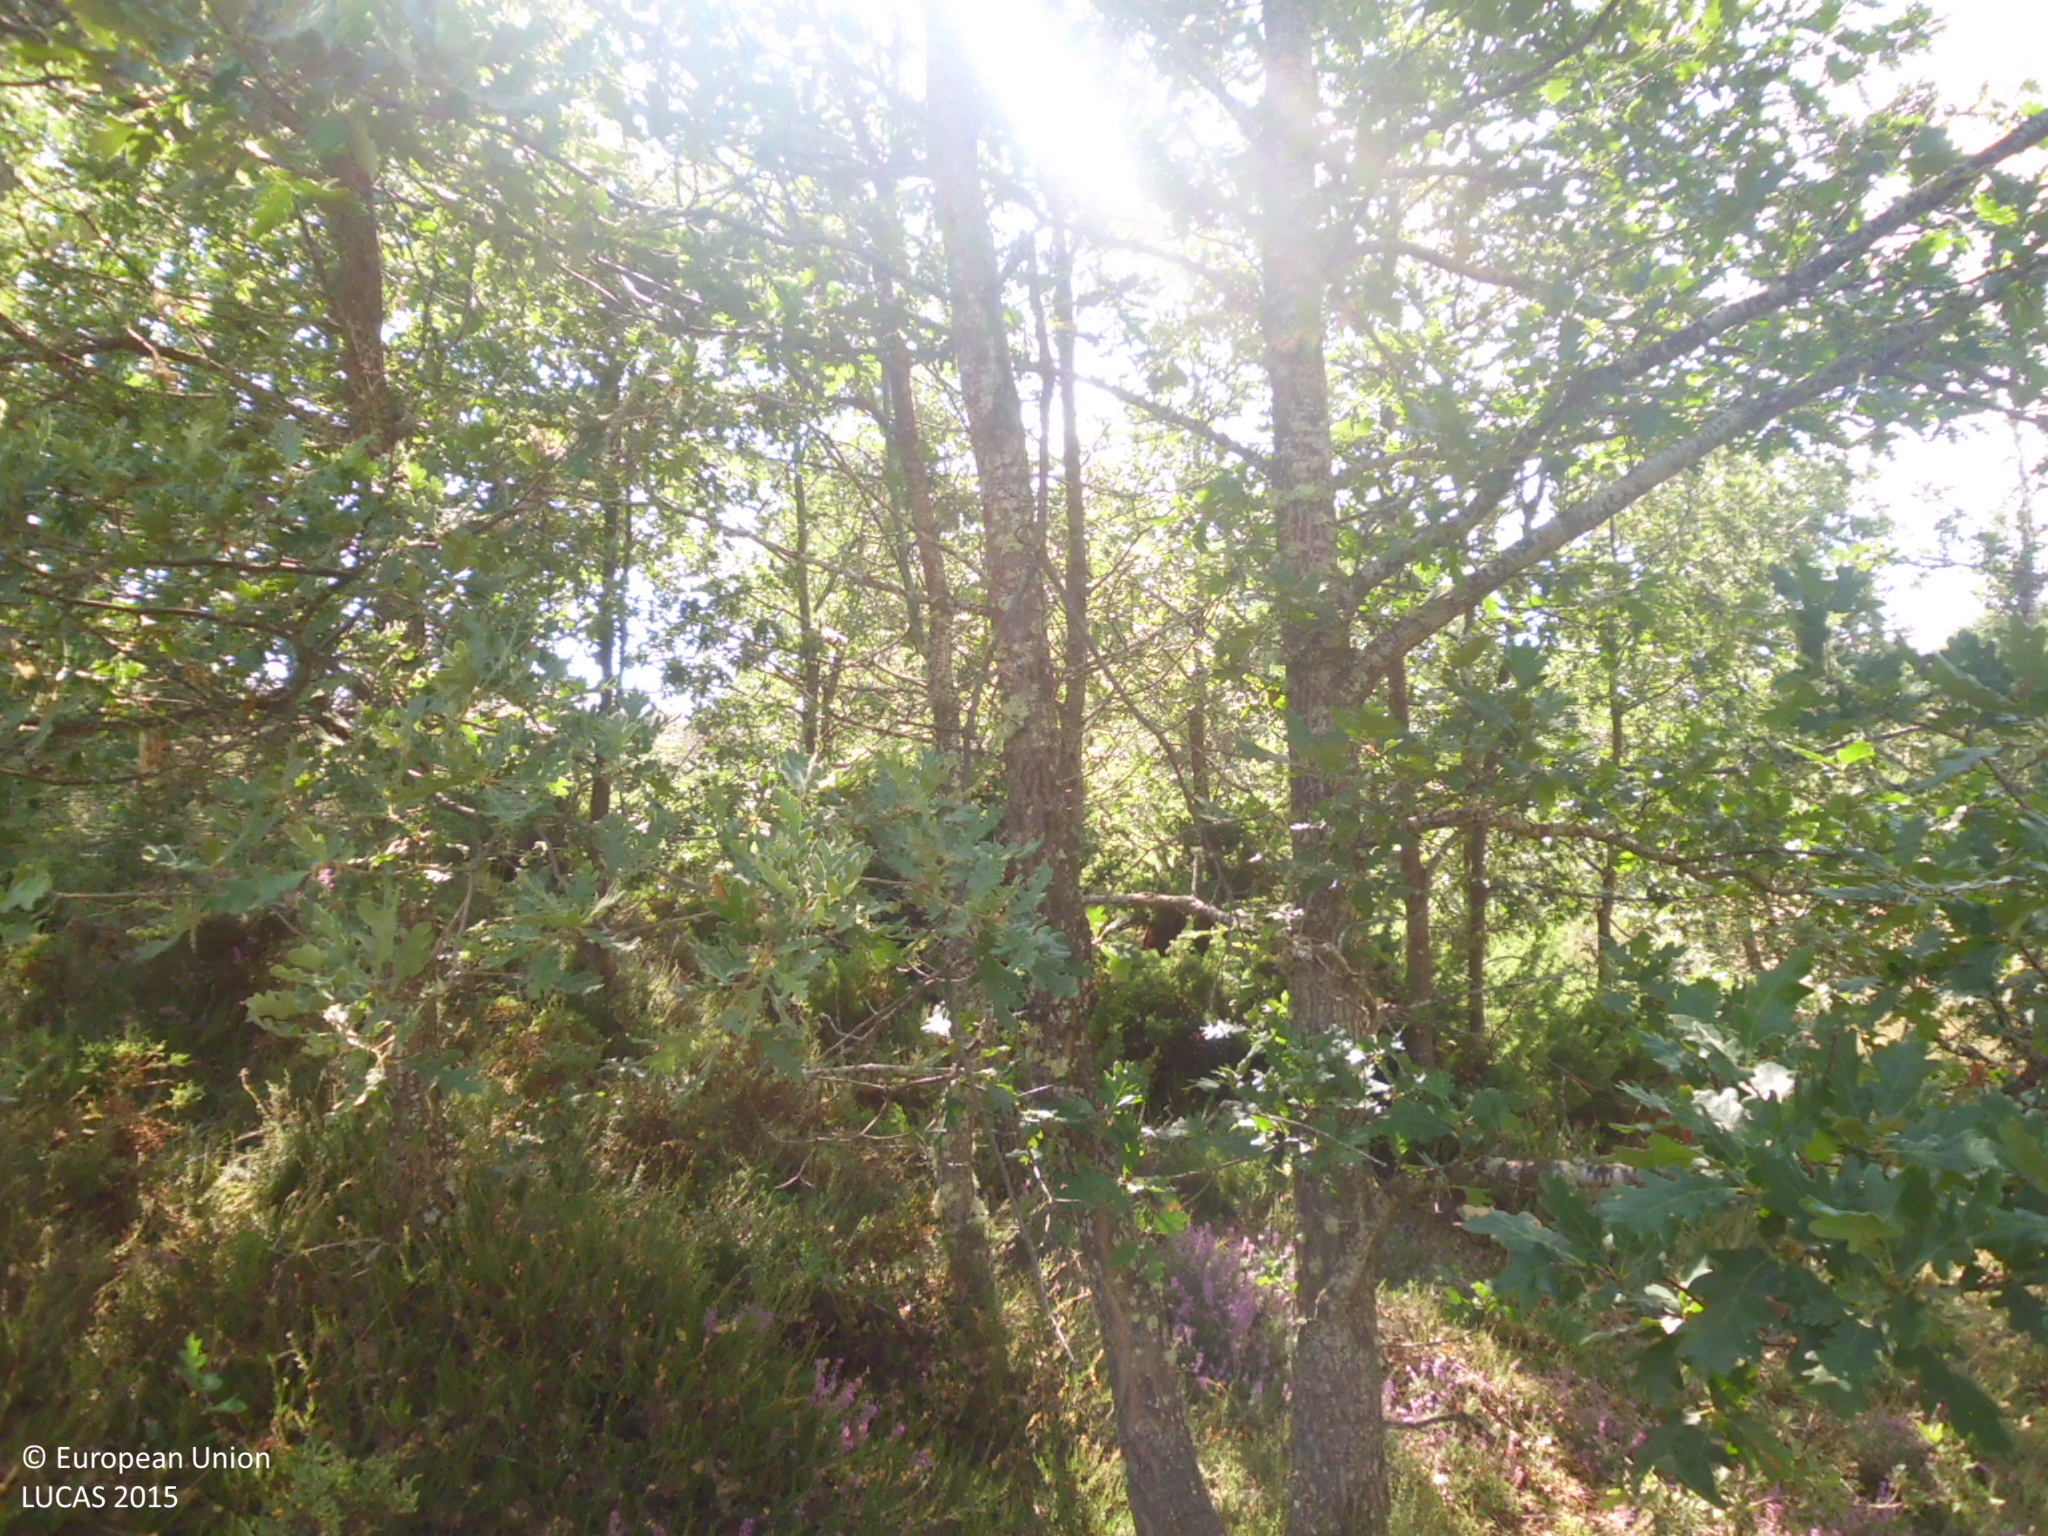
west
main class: Woodland
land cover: Broadleaved woodland
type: acidophilous oak and oak-birch forest
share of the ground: 10 - 25 %
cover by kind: shrubs 70 %, broadleaved forest trees 25 %, herbaceous plants 5 %
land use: Semi-natural and natural areas not in use
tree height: > 5 m
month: July
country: ES
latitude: 42.7427
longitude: -4.4803
